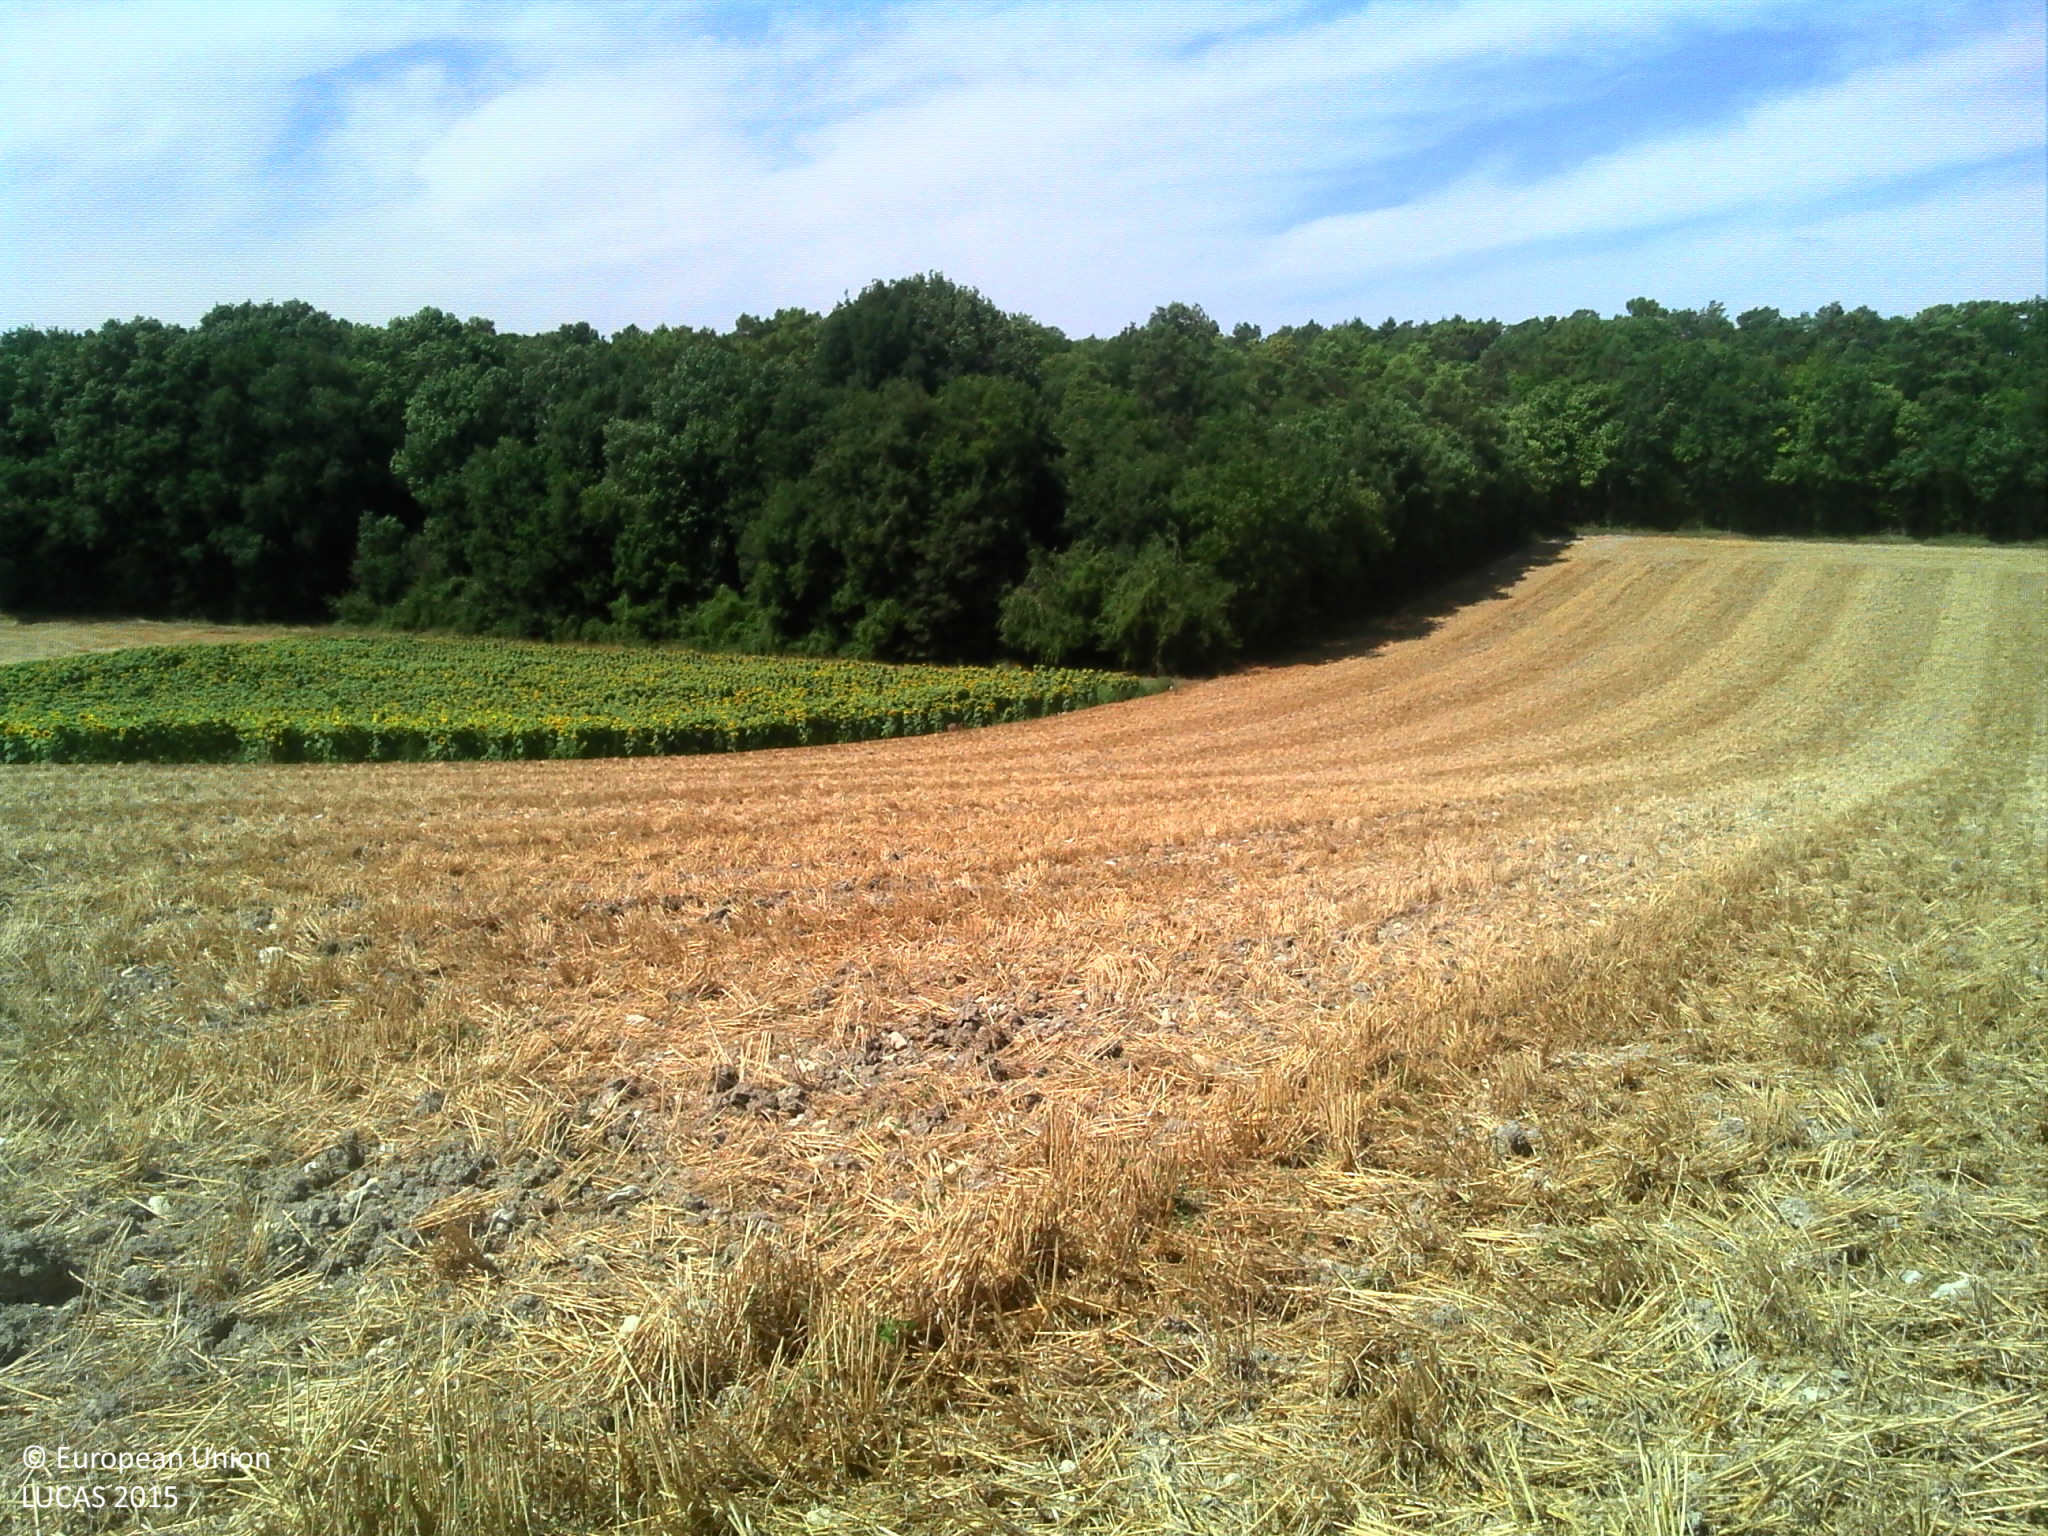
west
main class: Cropland
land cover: Common wheat
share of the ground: > 75 %
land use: Agriculture (excluding fallow land and kitchen gardens)
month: July
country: FR
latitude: 47.0792
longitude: 0.4044
